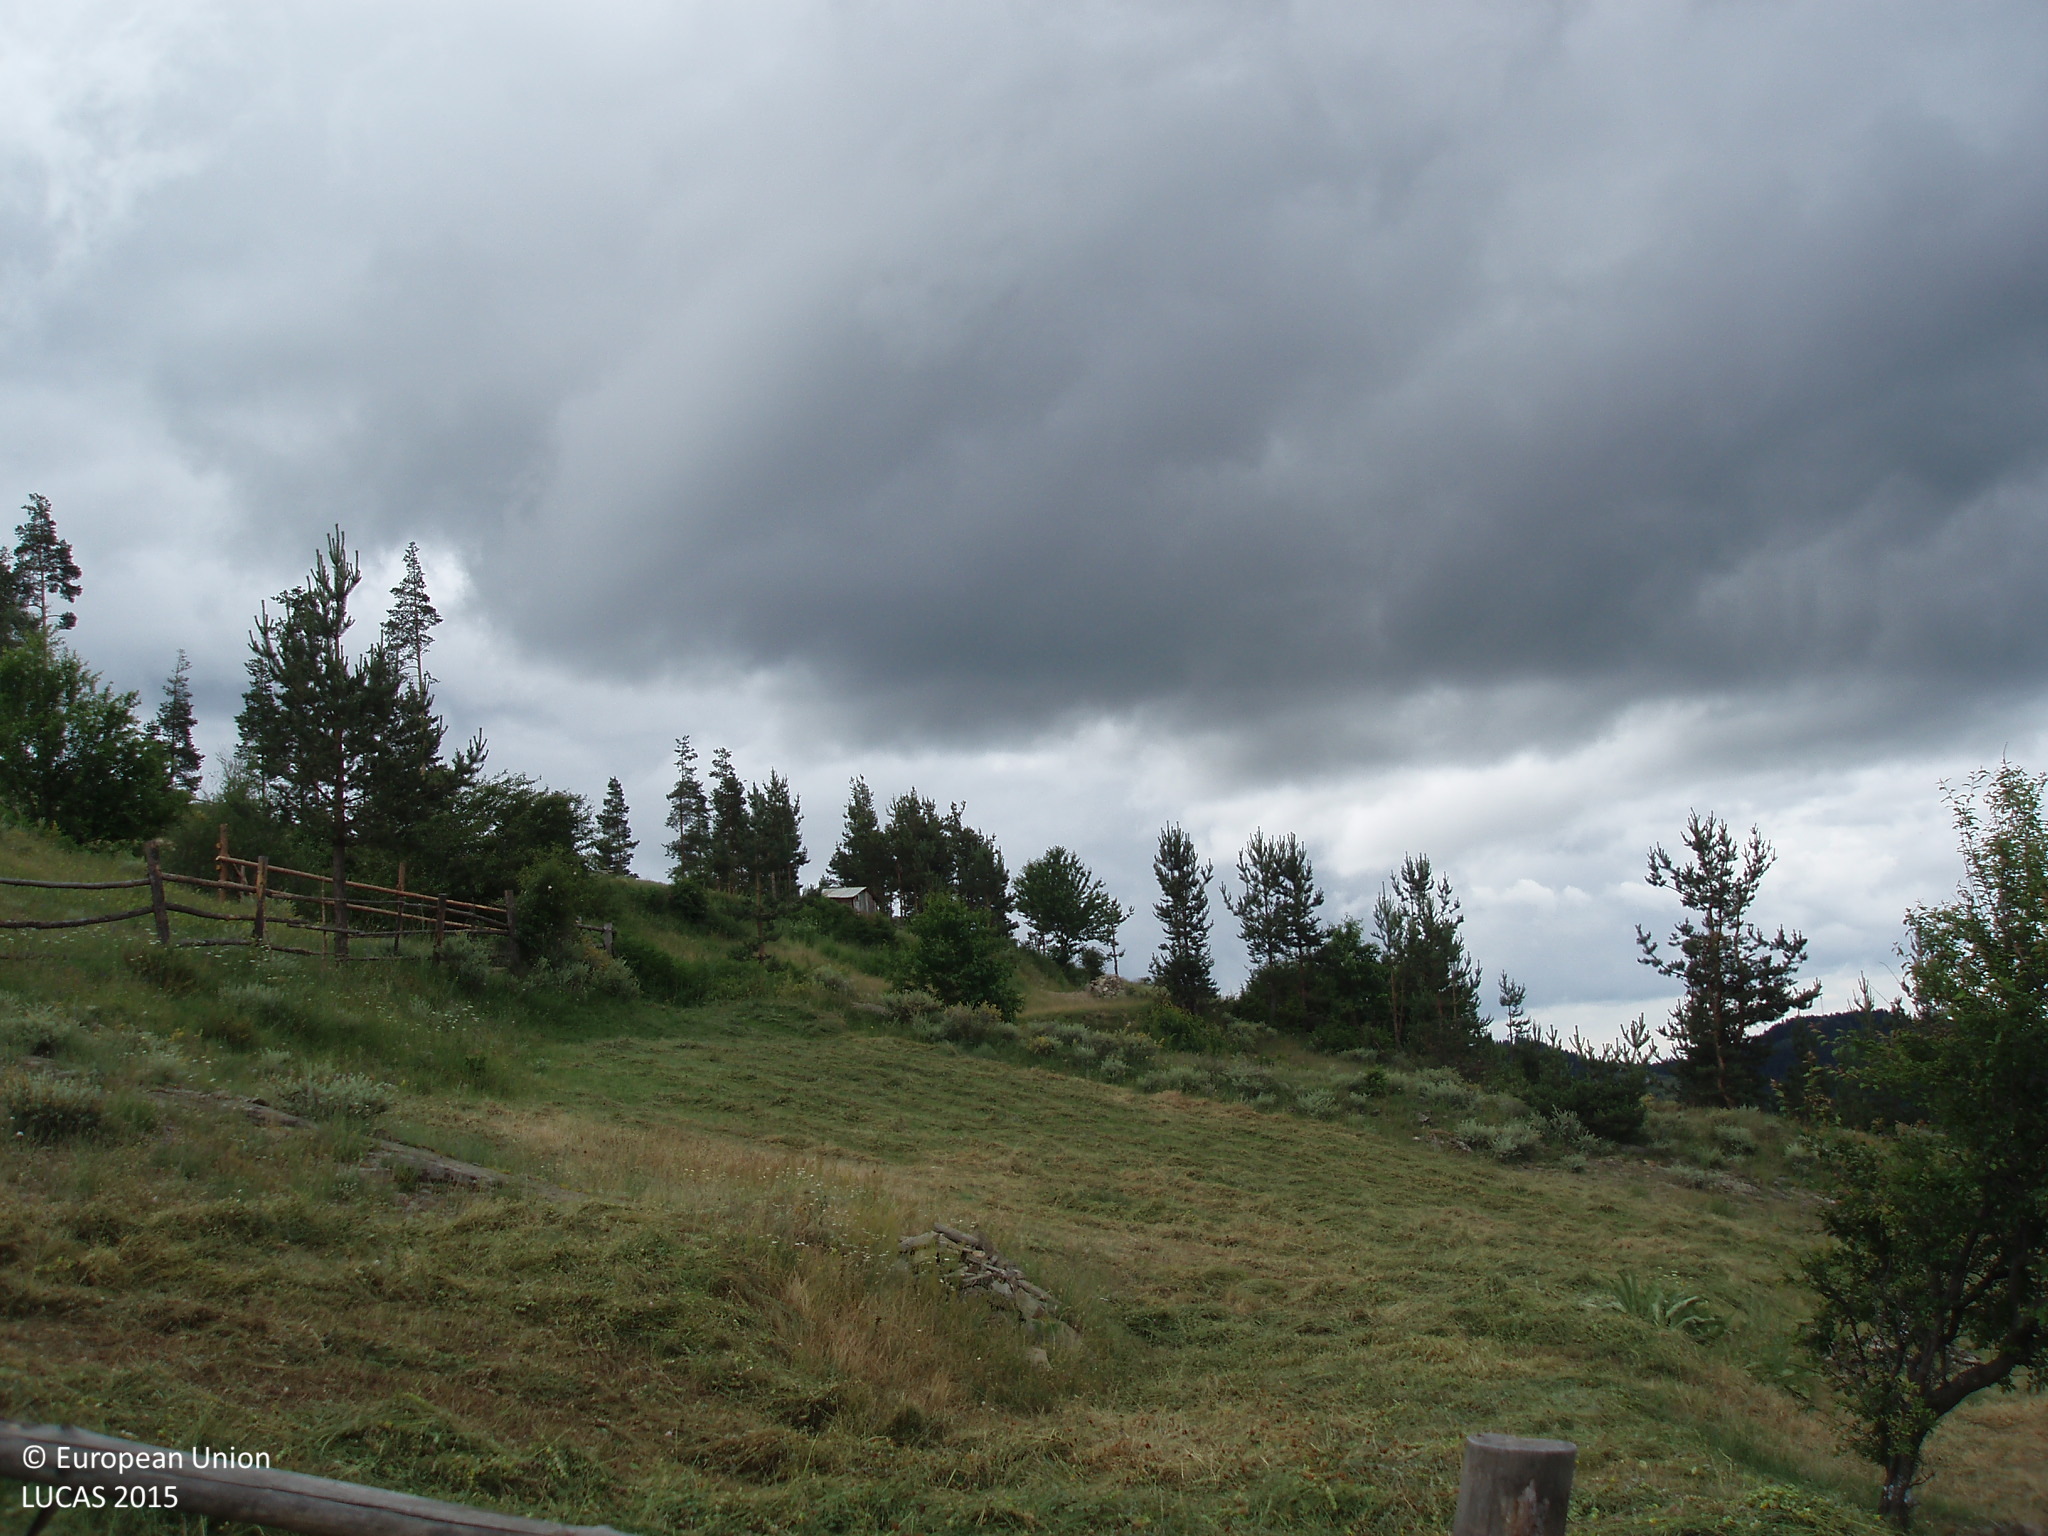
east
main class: Grassland
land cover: Grassland without tree/shrub cover
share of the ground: > 75 %
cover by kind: herbaceous plants 100 %
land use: Agriculture (excluding fallow land and kitchen gardens)
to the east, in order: Grassland without tree/shrub cover; Fences; Grassland without tree/shrub cover; Grassland with sparse tree/shrub cover; Pine dominated coniferous woodland; Paved roads, cycling and walking lanes; Pine dominated coniferous woodland; Tracks; Pine dominated coniferous woodland
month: June
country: BG
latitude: 41.7266
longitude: 23.7711
